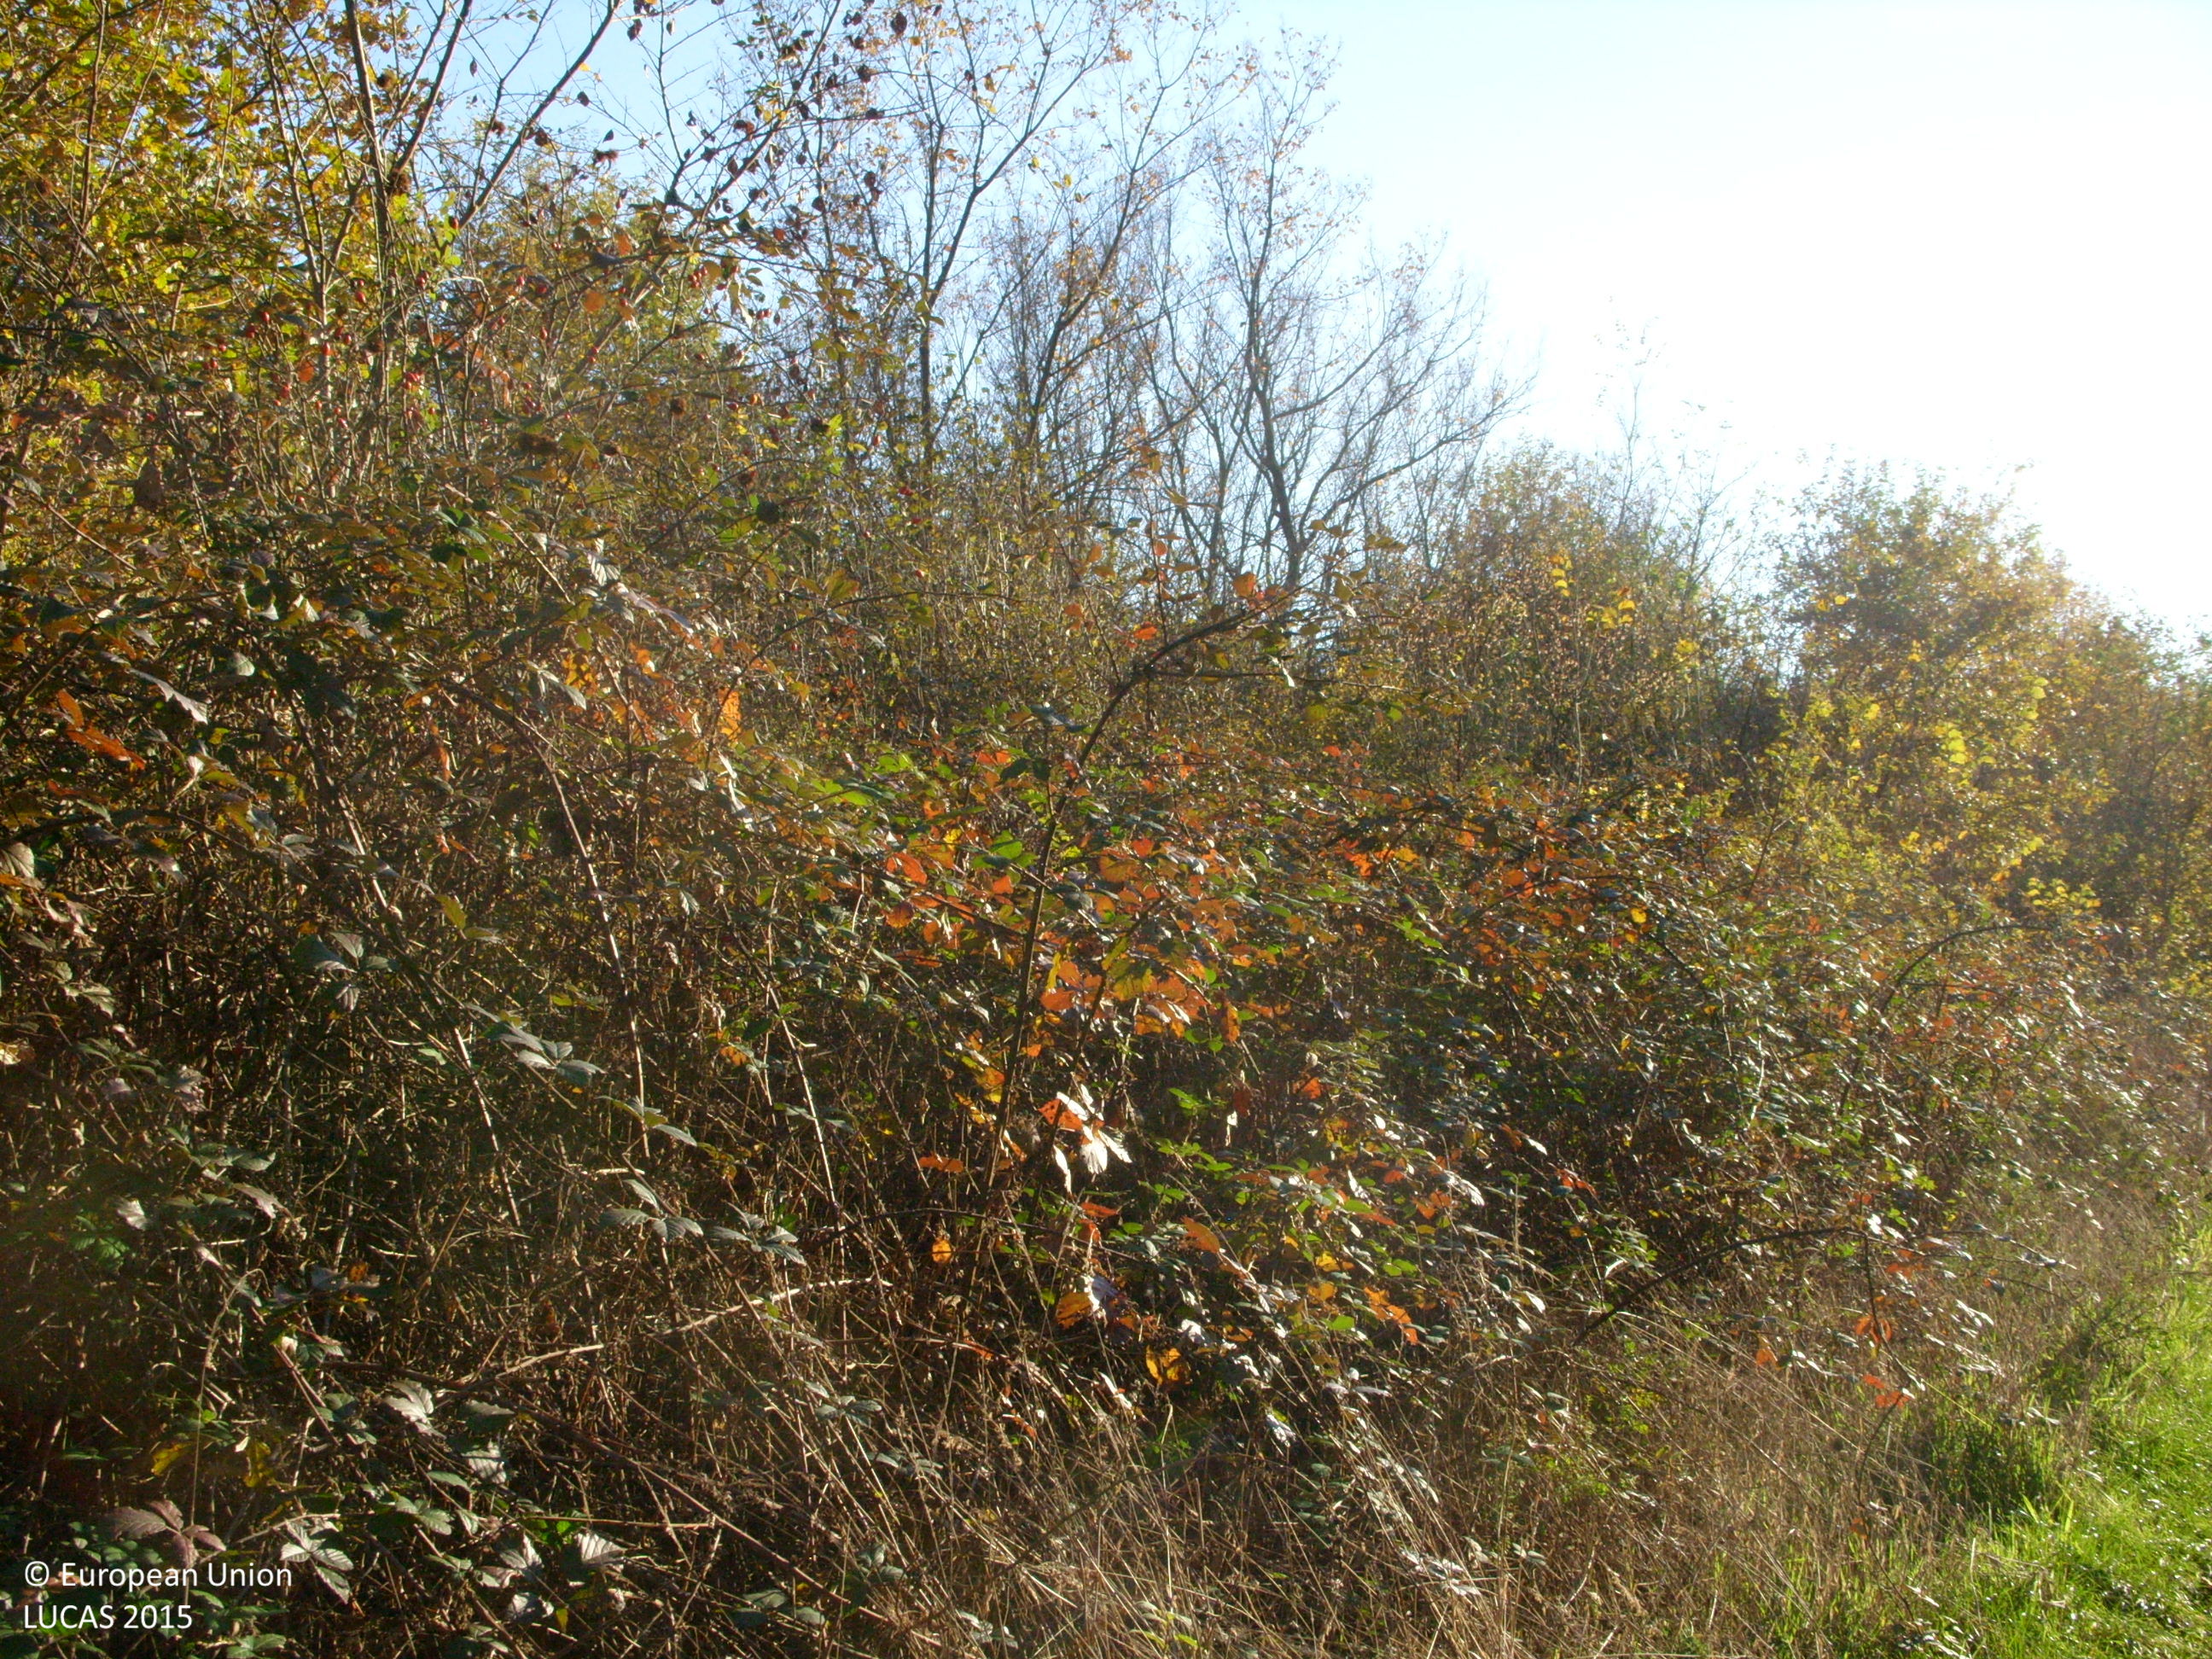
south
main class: Woodland
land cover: Broadleaved woodland
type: mesophytic deciduous forest
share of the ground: > 75 %
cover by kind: broadleaved forest trees 90 %, shrubs 5 %, unconsolidated bare surface 5 %
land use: Forestry
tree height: > 5 m
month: November
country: BG
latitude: 42.4005
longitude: 24.8170
